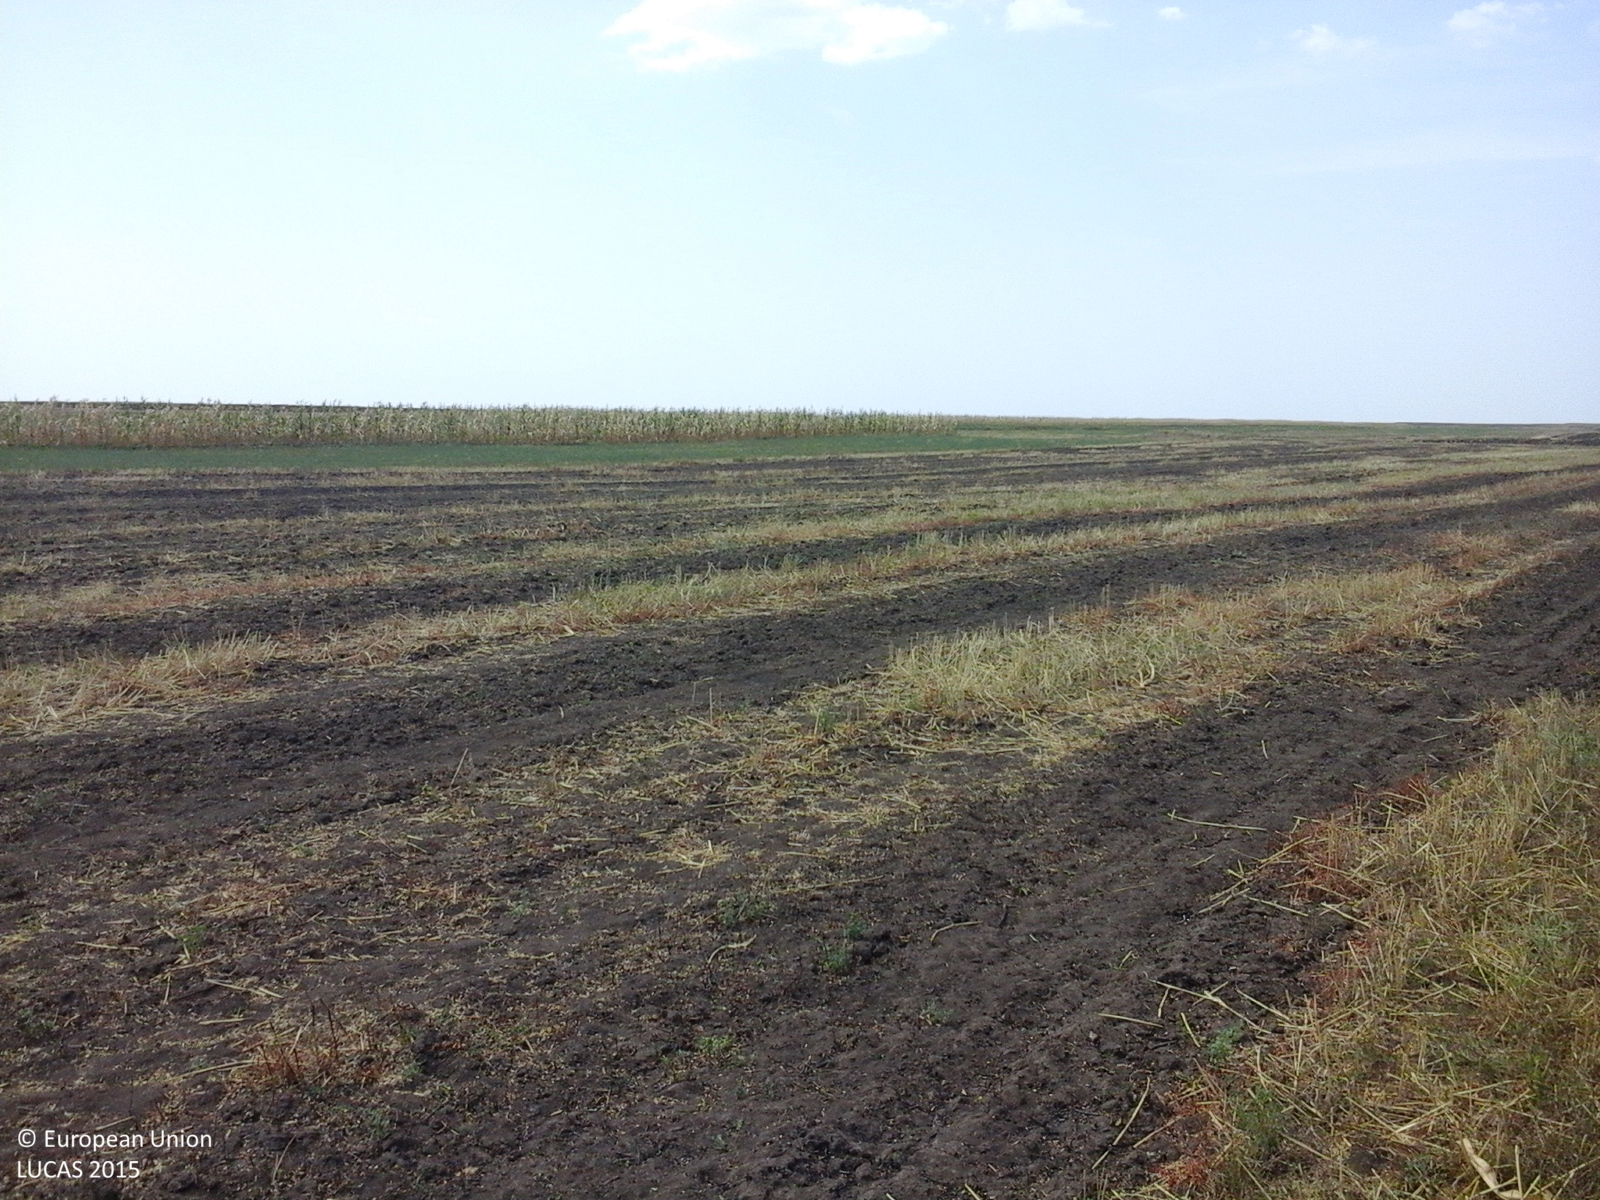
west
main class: Cropland
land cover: Maize
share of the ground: 10 - 25 %
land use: Agriculture (excluding fallow land and kitchen gardens)
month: August
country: RO
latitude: 44.2245
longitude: 23.1267
